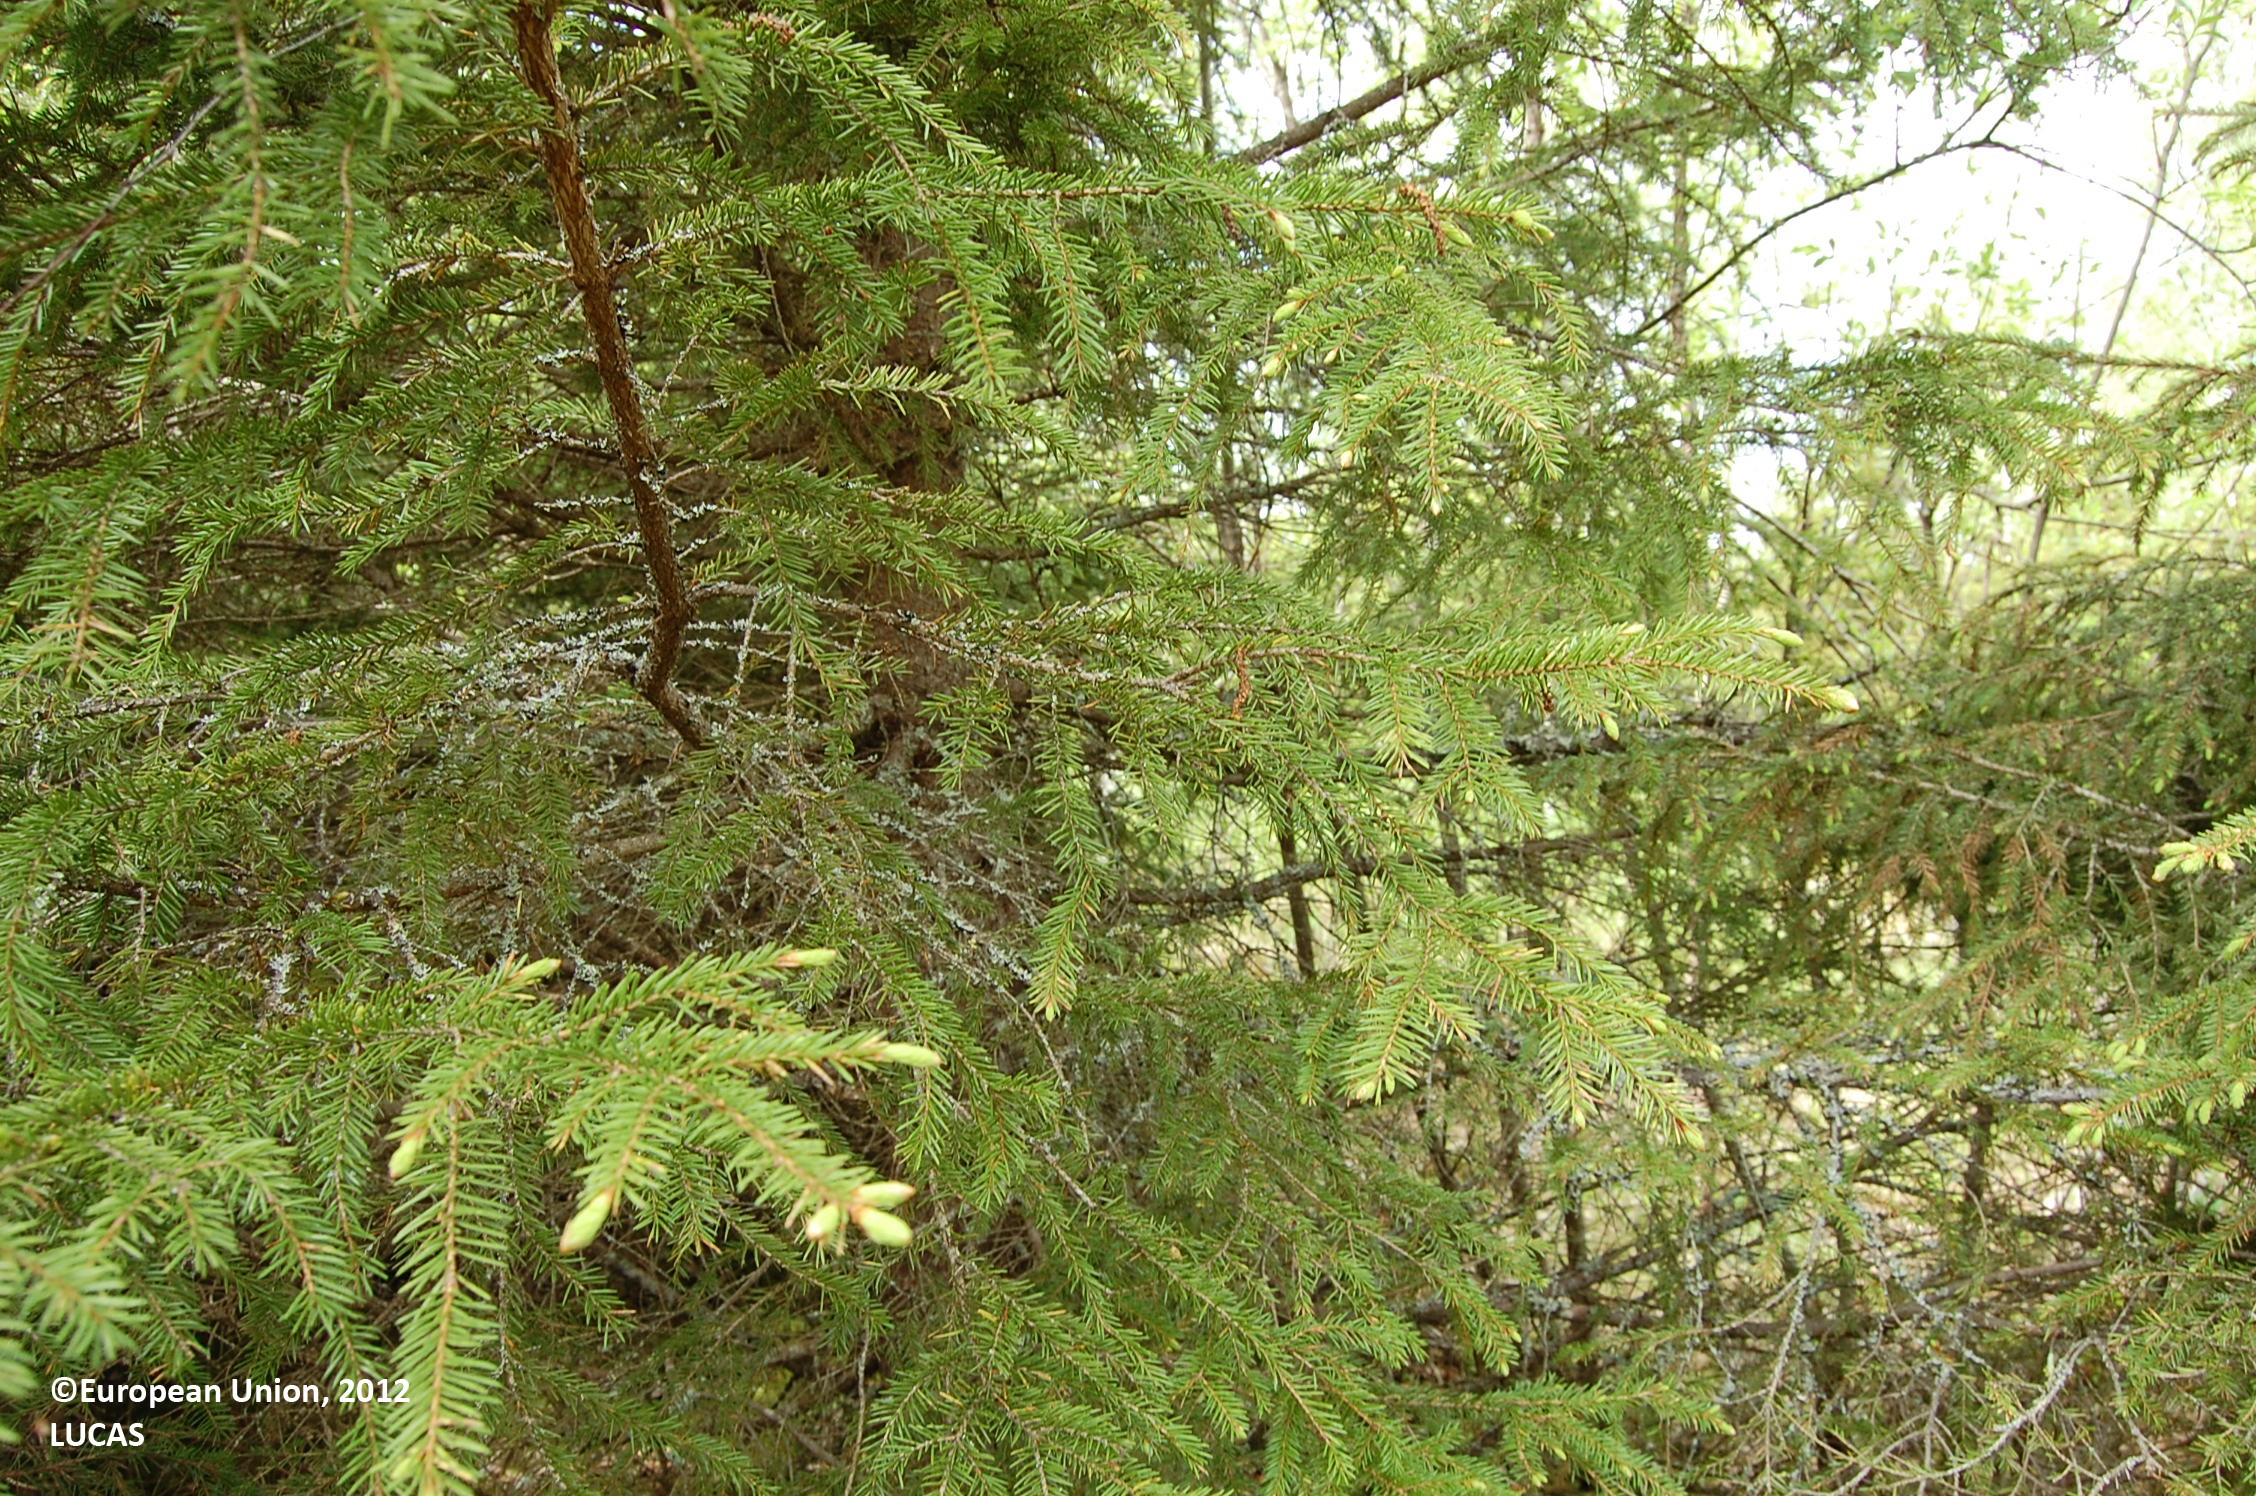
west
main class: Woodland
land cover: Spruce dominated mixed woodland
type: hemiboreal forest and nemoral coniferous forest and mixed broadleaved-coniferous forest
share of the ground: 50 - 75 %
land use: Forestry
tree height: > 5 m
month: June
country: FI
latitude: 64.0096
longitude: 26.1254
